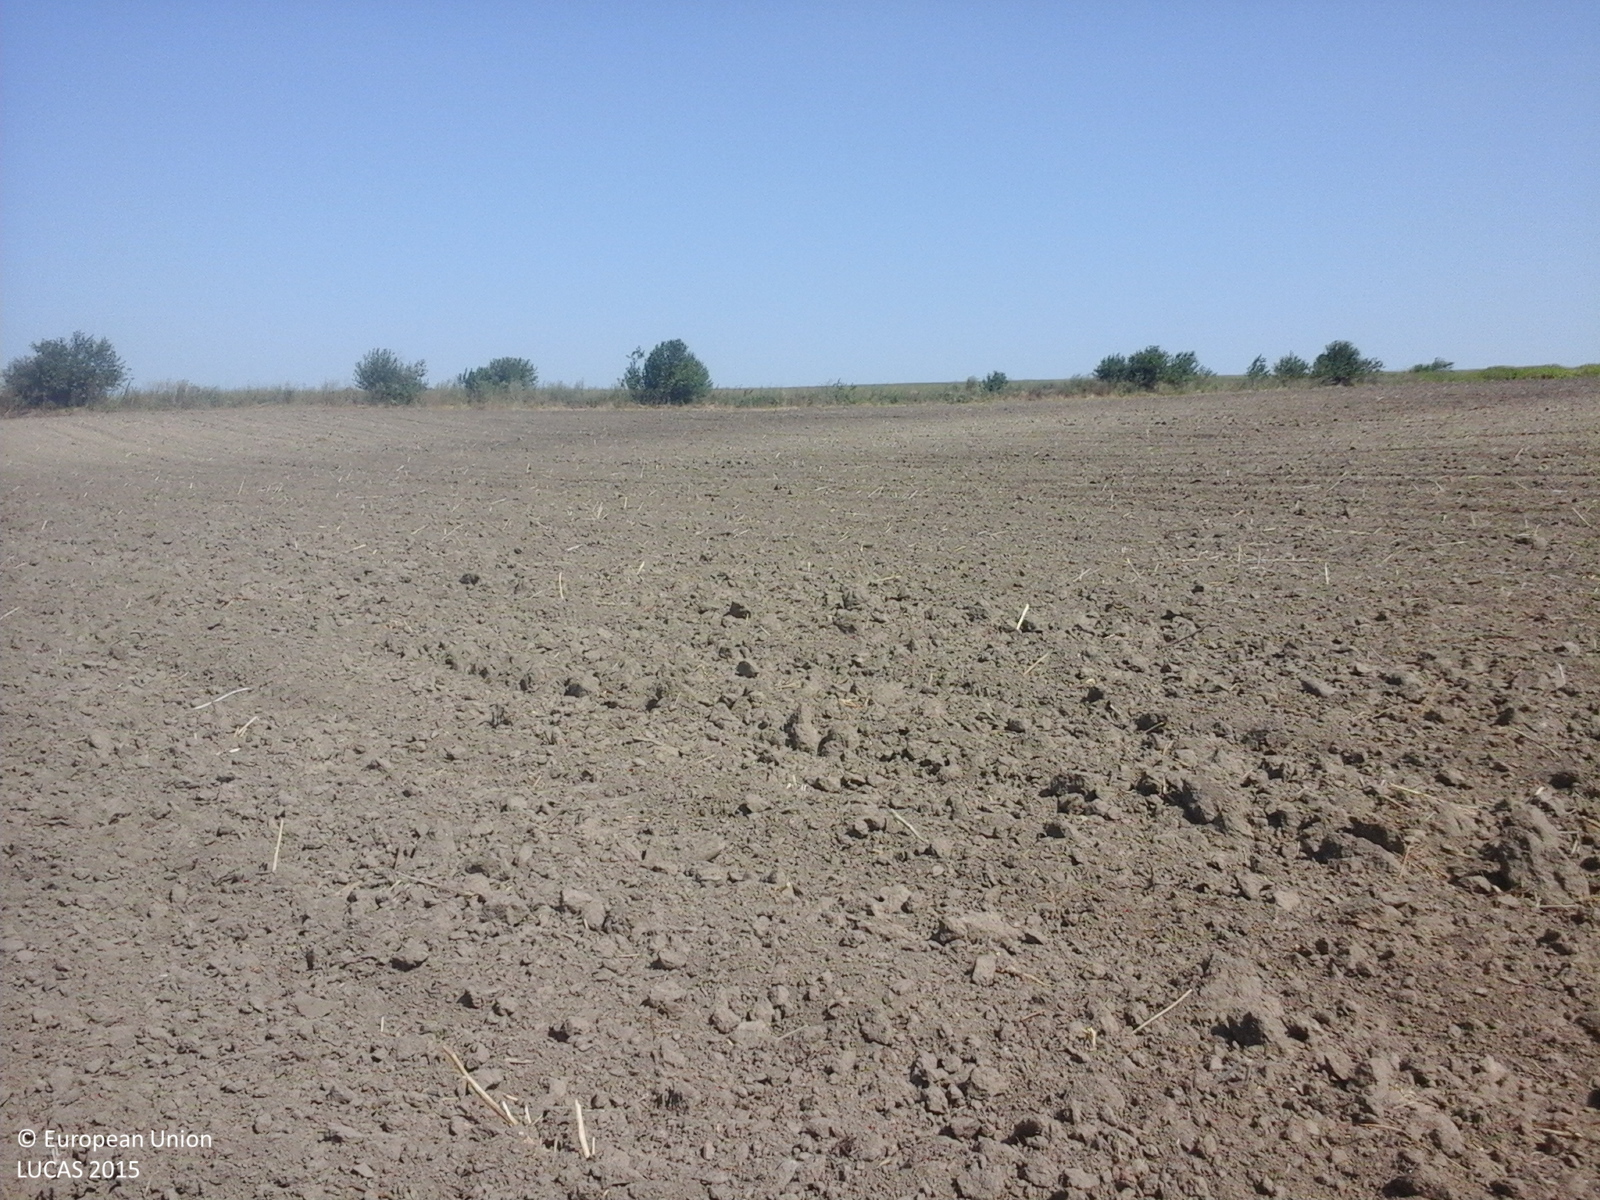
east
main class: Cropland
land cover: Rape and turnip rape
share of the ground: < 10 %
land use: Agriculture (excluding fallow land and kitchen gardens)
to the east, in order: Rape and turnip rape; Abandoned hedges; Spontaneously vegetated surfaces; Grass margins; Tracks; Grass margins; Maize; Grassland without tree/shrub cover
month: August
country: RO
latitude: 44.5549
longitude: 28.0747
